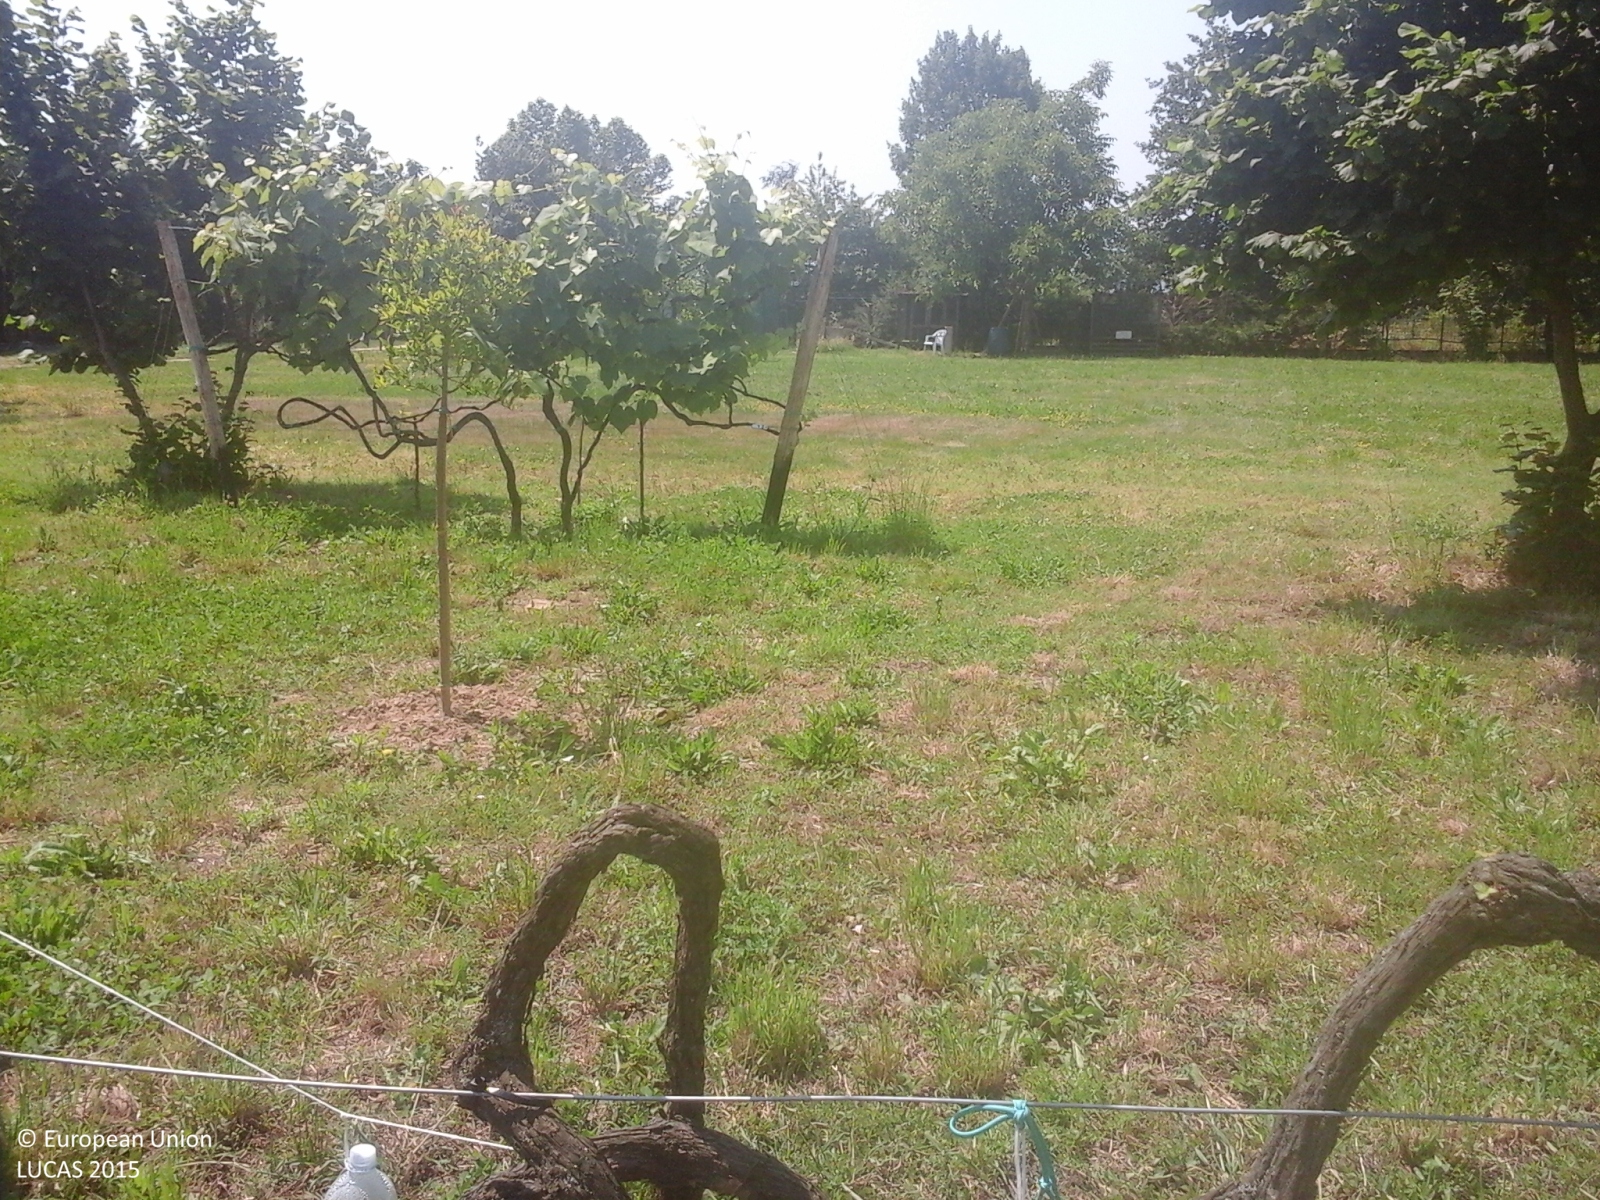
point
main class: Cropland
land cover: Clovers
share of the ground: > 75 %
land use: Agriculture (excluding fallow land and kitchen gardens)
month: June
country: IT
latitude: 43.8764
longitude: 11.0303
